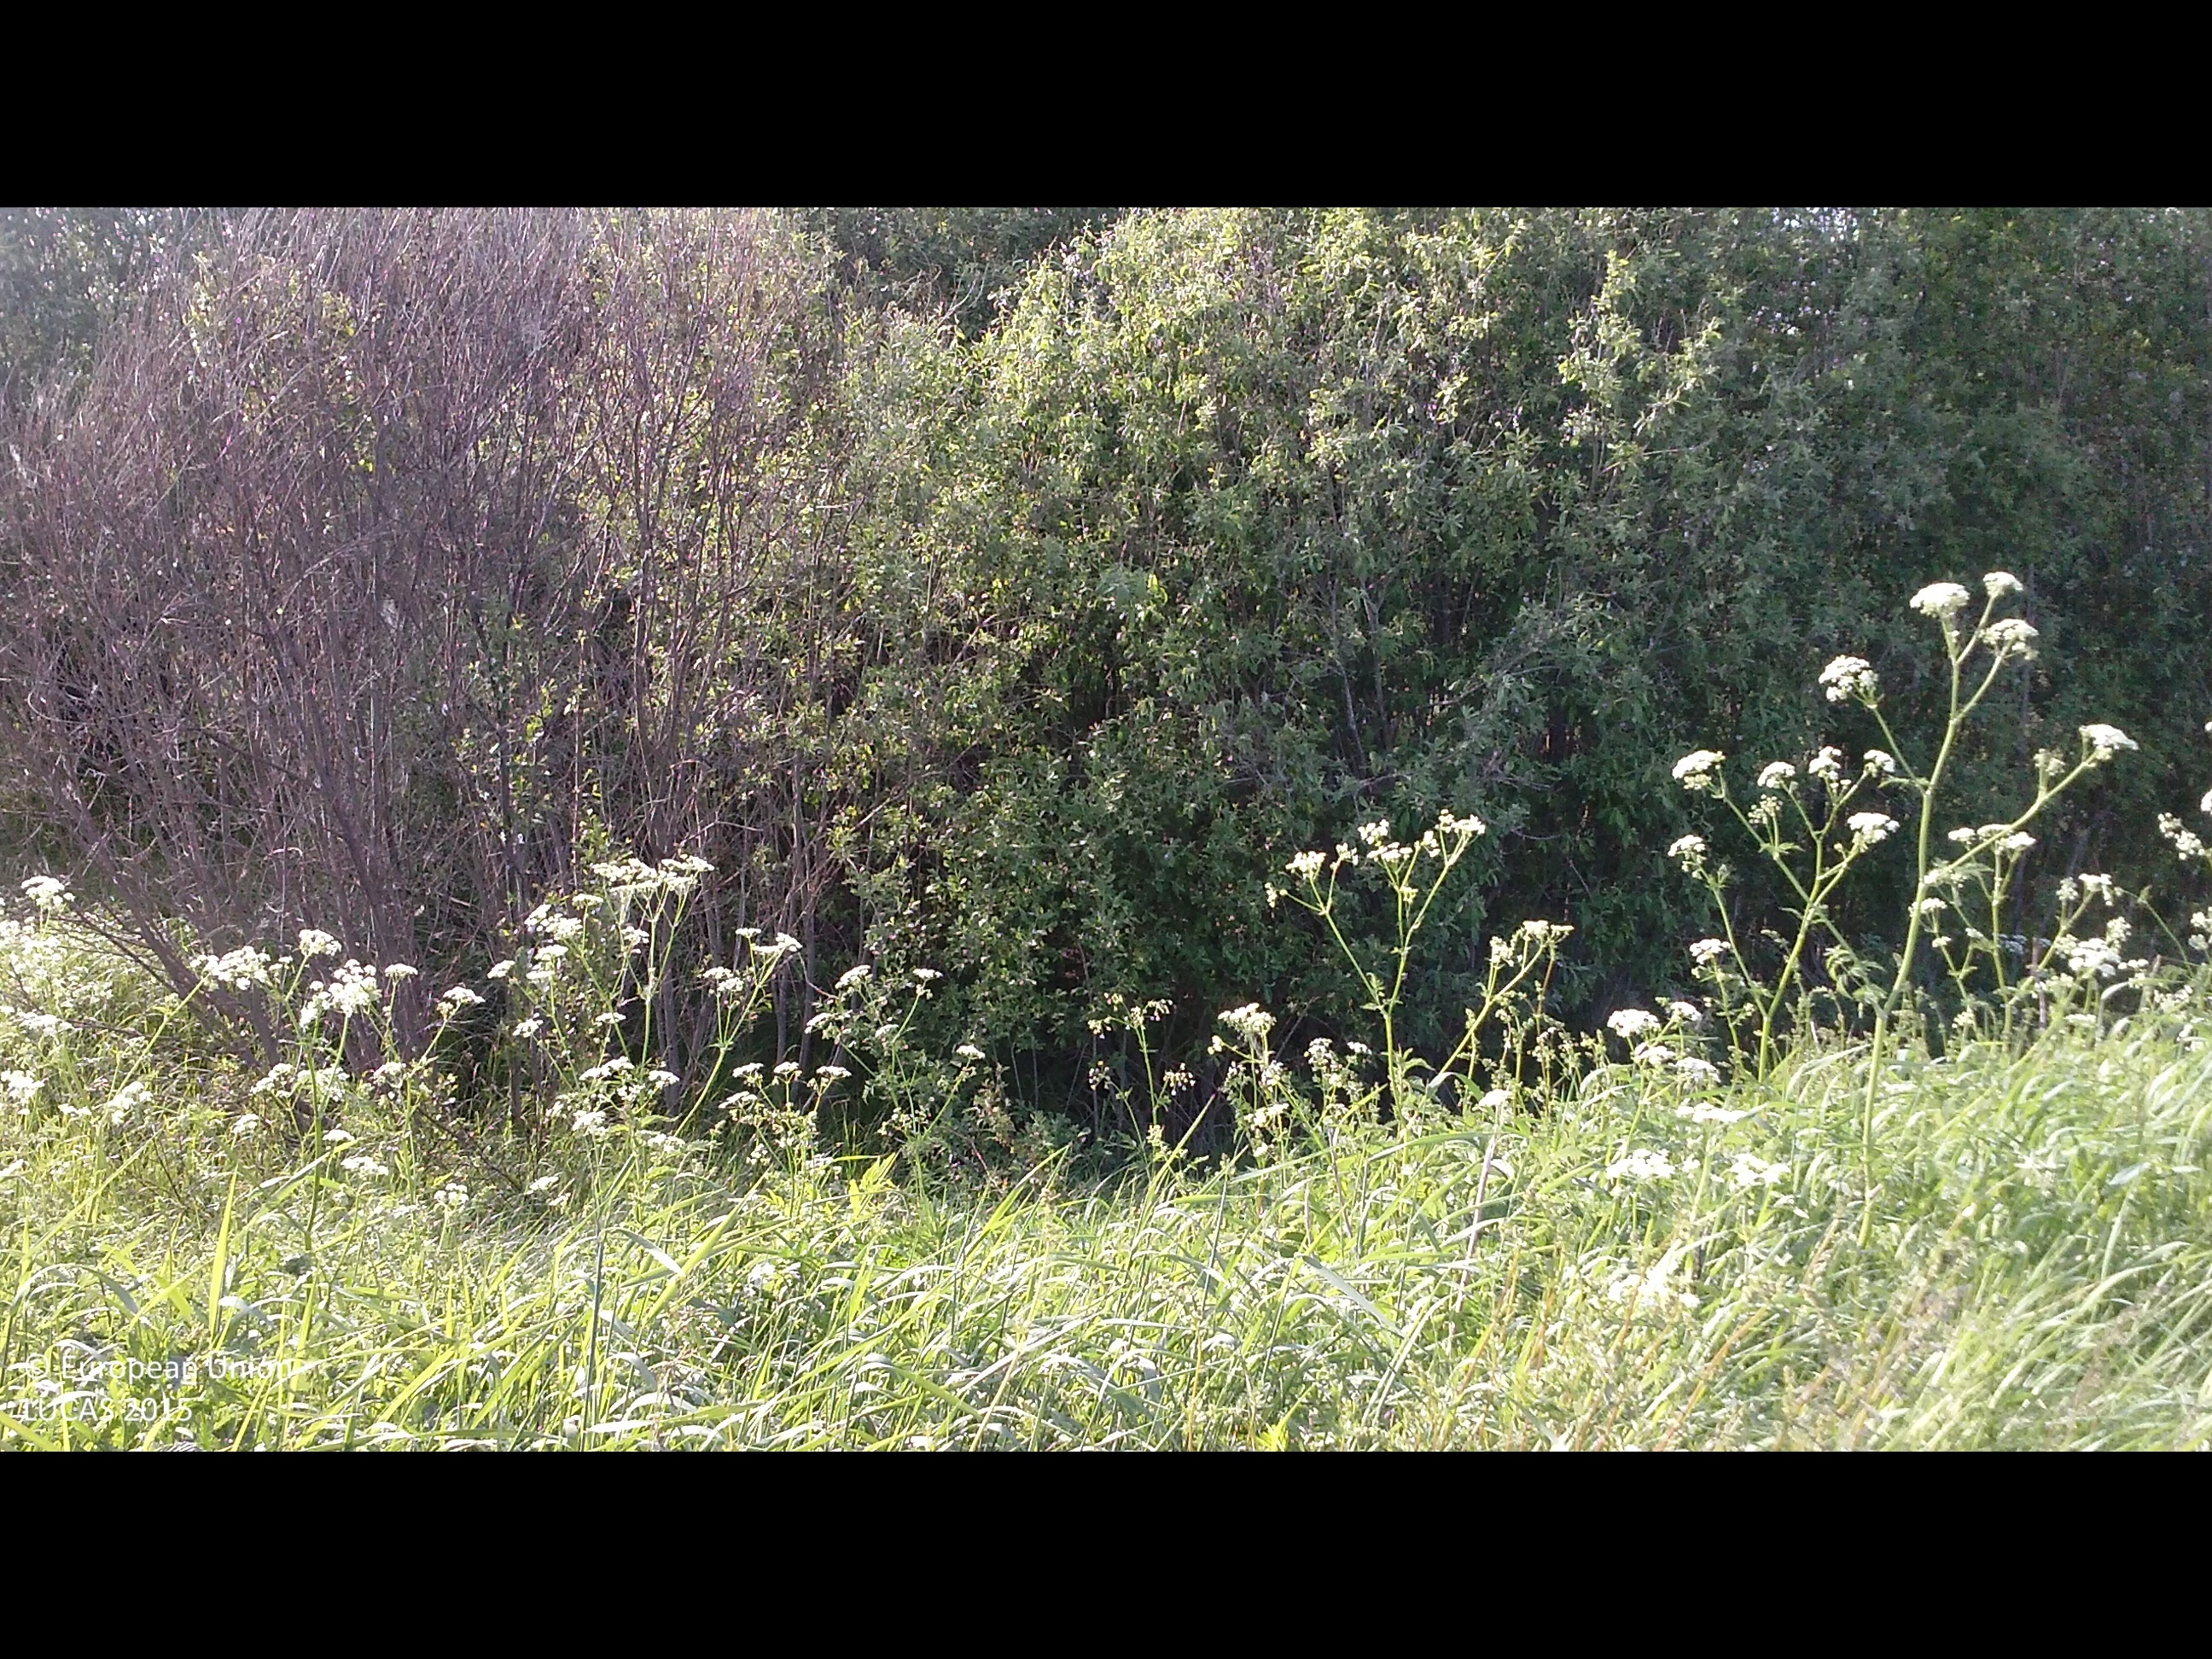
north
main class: Woodland
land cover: Broadleaved woodland
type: non-riverine alder, birch or aspen forest
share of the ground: 50 - 75 %
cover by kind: broadleaved forest trees 65 %, herbaceous plants 30 %, shrubs 5 %
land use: Forestry
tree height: < 5 m
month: June
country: LV
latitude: 56.3210
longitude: 28.1337
